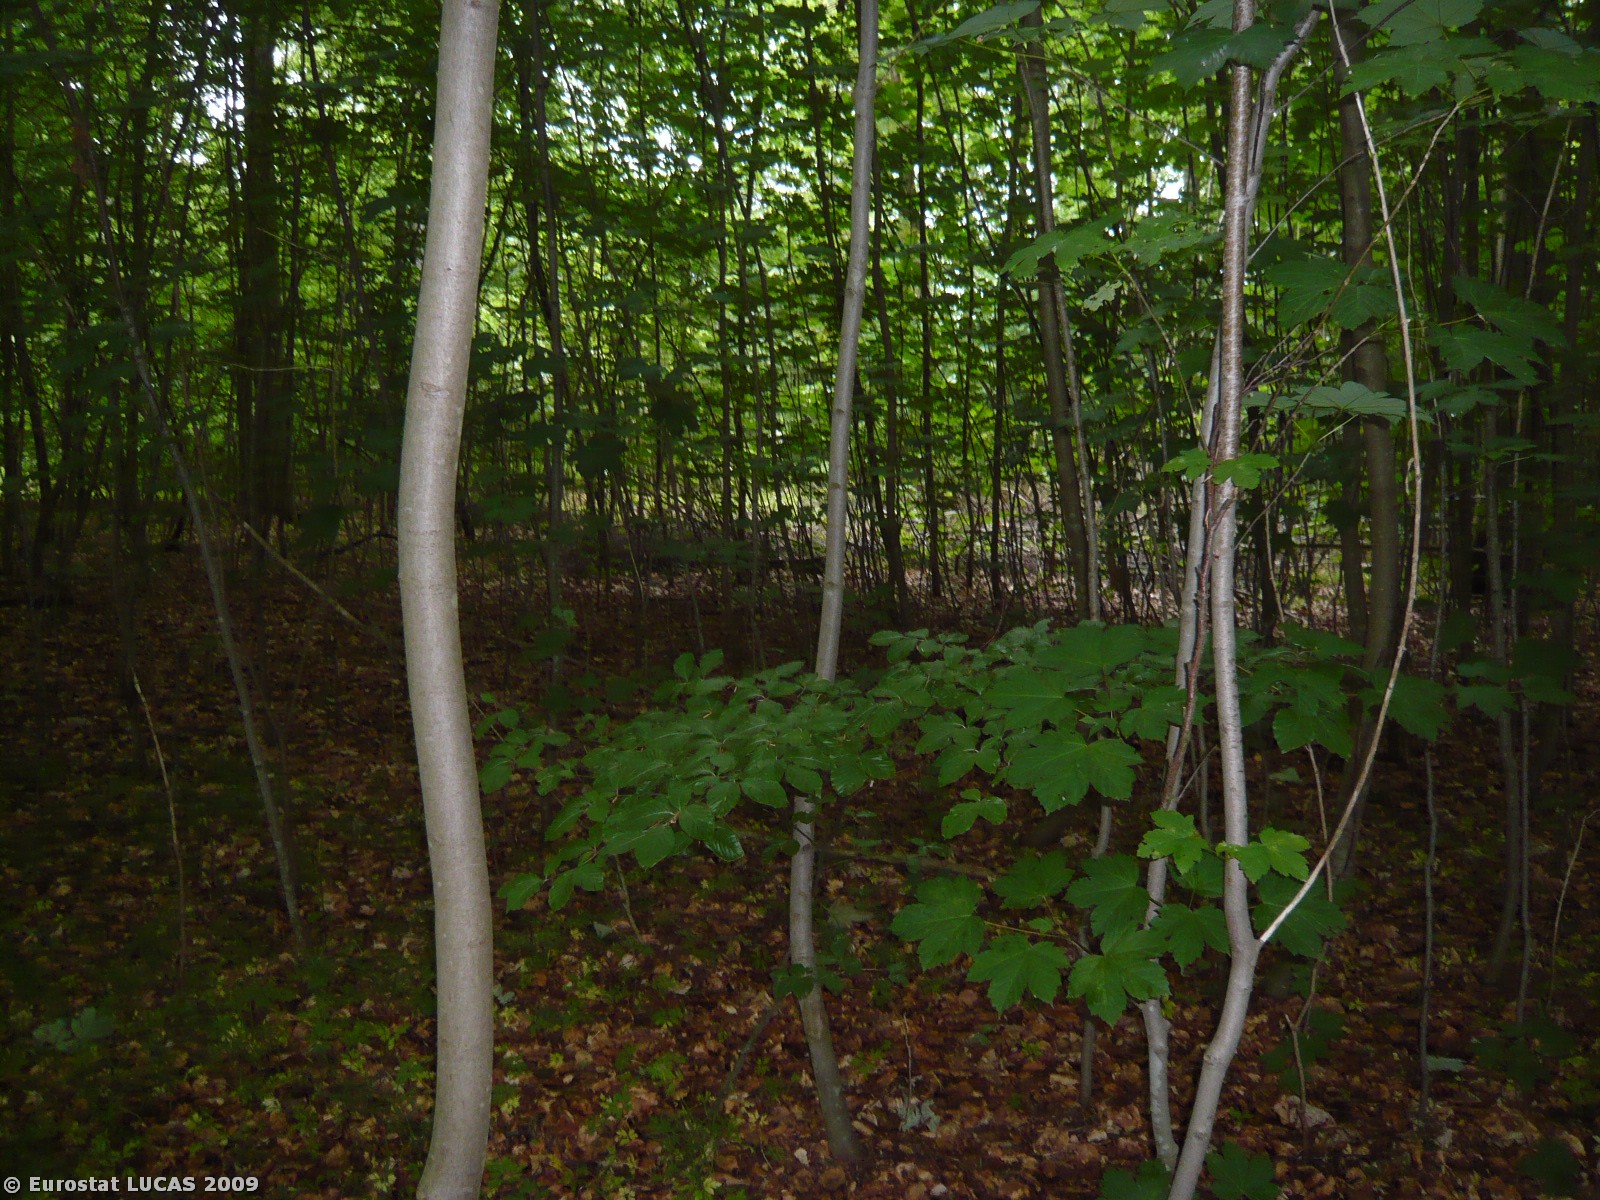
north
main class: Woodland
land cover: Broadleaved woodland
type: mesophytic deciduous forest
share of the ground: > 75 %
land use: Forestry
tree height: > 5 m
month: June
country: DK
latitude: 54.7007
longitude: 11.8144
